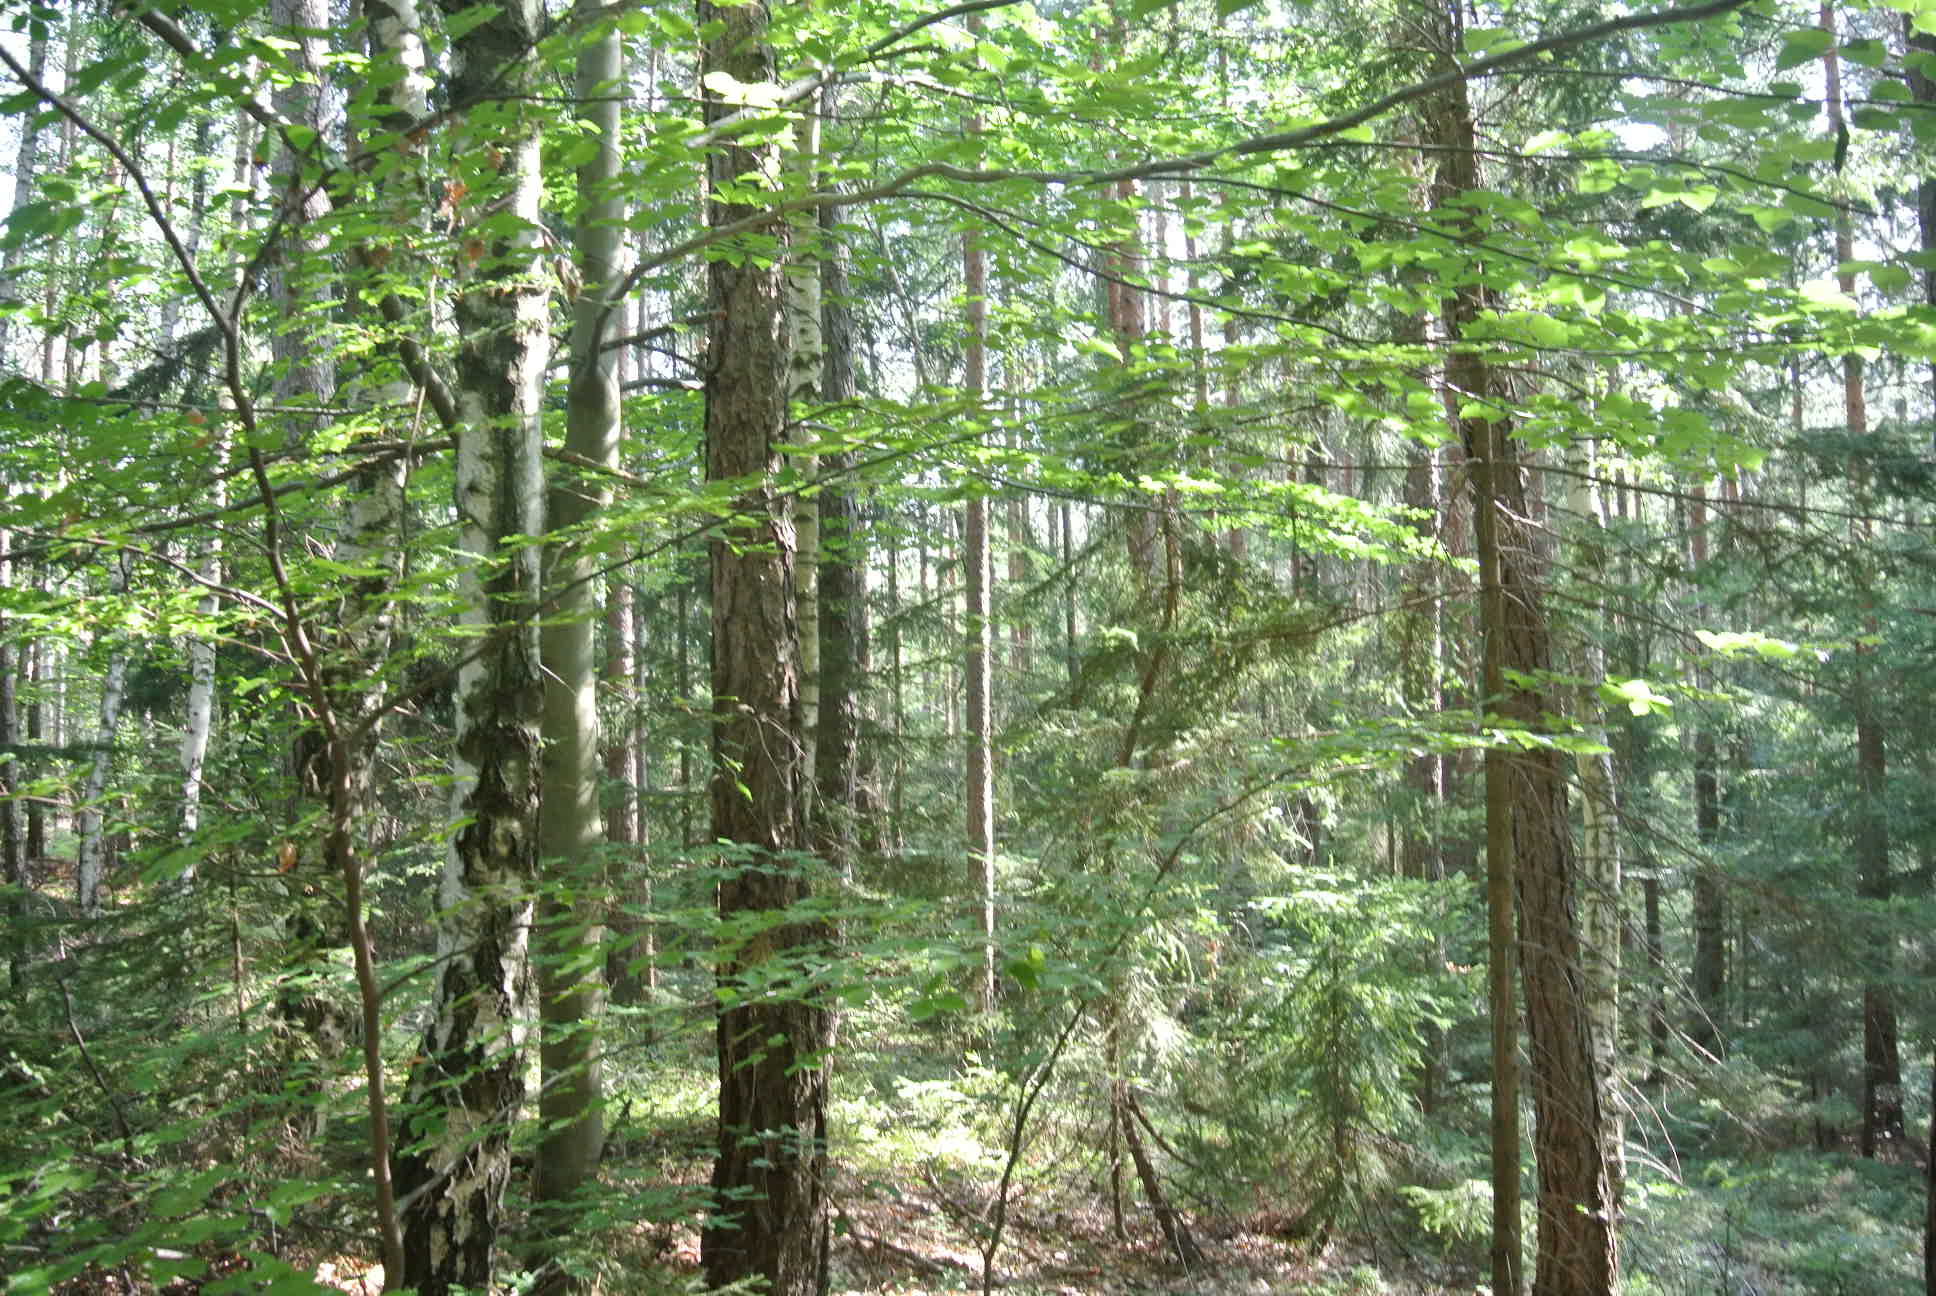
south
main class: Woodland
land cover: Pine dominated mixed woodland
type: alpine coniferous forest
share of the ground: > 75 %
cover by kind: coniferous forest trees 70 %, broadleaved forest trees 30 %
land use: Forestry
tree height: > 5 m
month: July
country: AT
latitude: 47.5462
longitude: 16.1546
